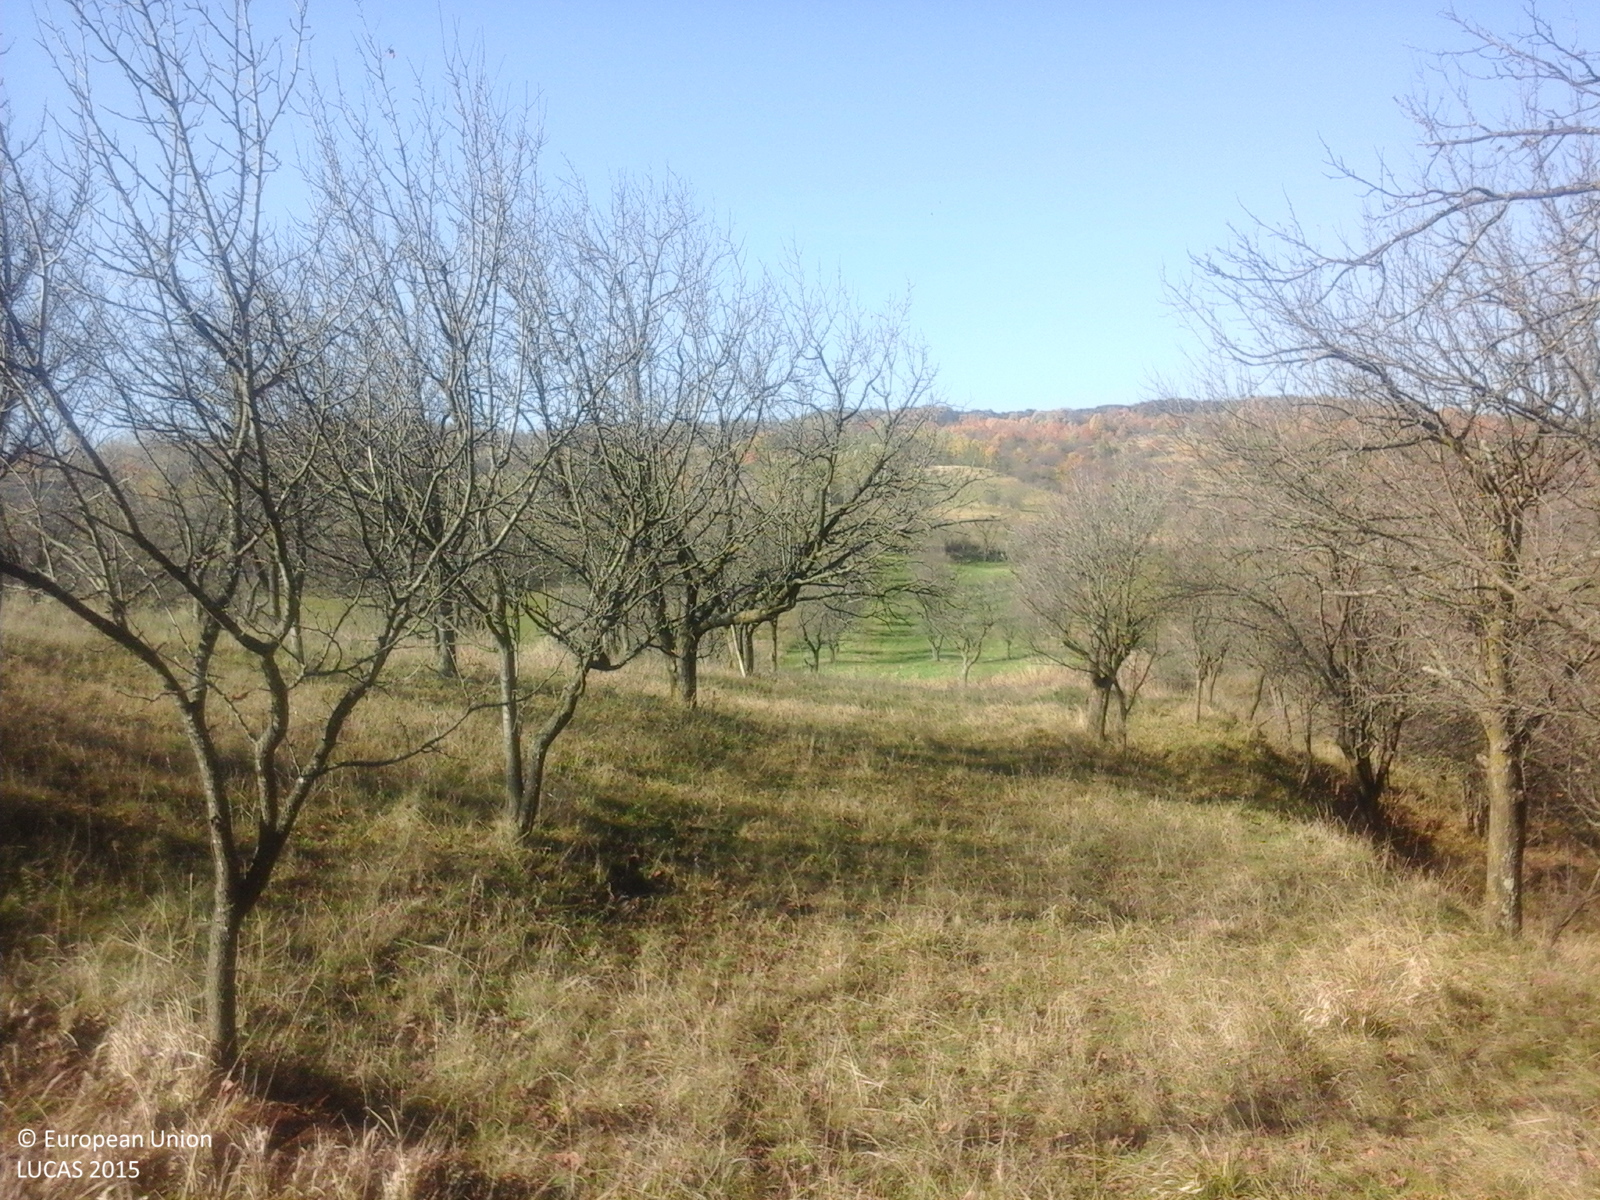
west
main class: Cropland
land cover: Other fruit trees and berries
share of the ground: > 75 %
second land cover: Grassland without tree/shrub cover
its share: > 75 %
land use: Agriculture (excluding fallow land and kitchen gardens)
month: October
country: RO
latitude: 45.4402
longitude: 26.8693
